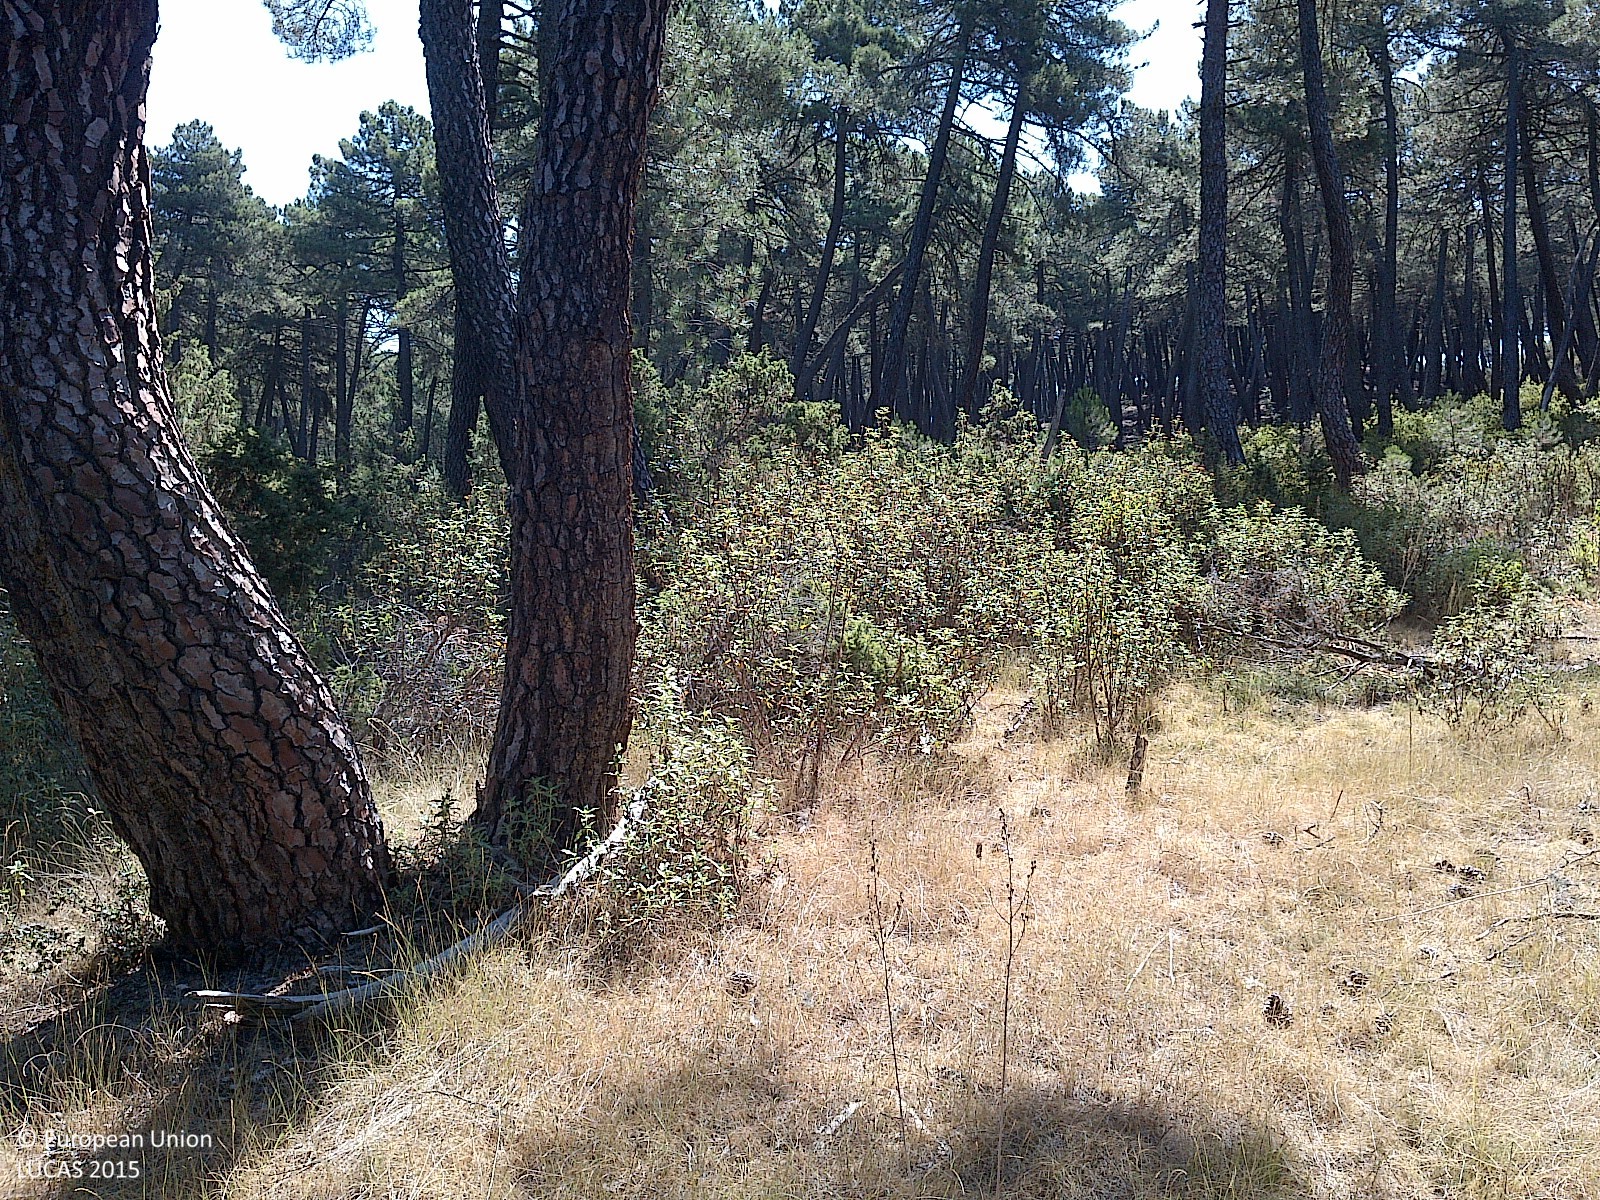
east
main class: Woodland
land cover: Pine dominated coniferous woodland
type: coniferous forest of the mediterranean region
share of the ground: 25 - 50 %
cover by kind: coniferous forest trees 40 %, shrubs 30 %, herbaceous plants 30 %
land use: Forestry
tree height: > 5 m
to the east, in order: Pine dominated coniferous woodland
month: July
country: ES
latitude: 41.7892
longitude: -3.1752
